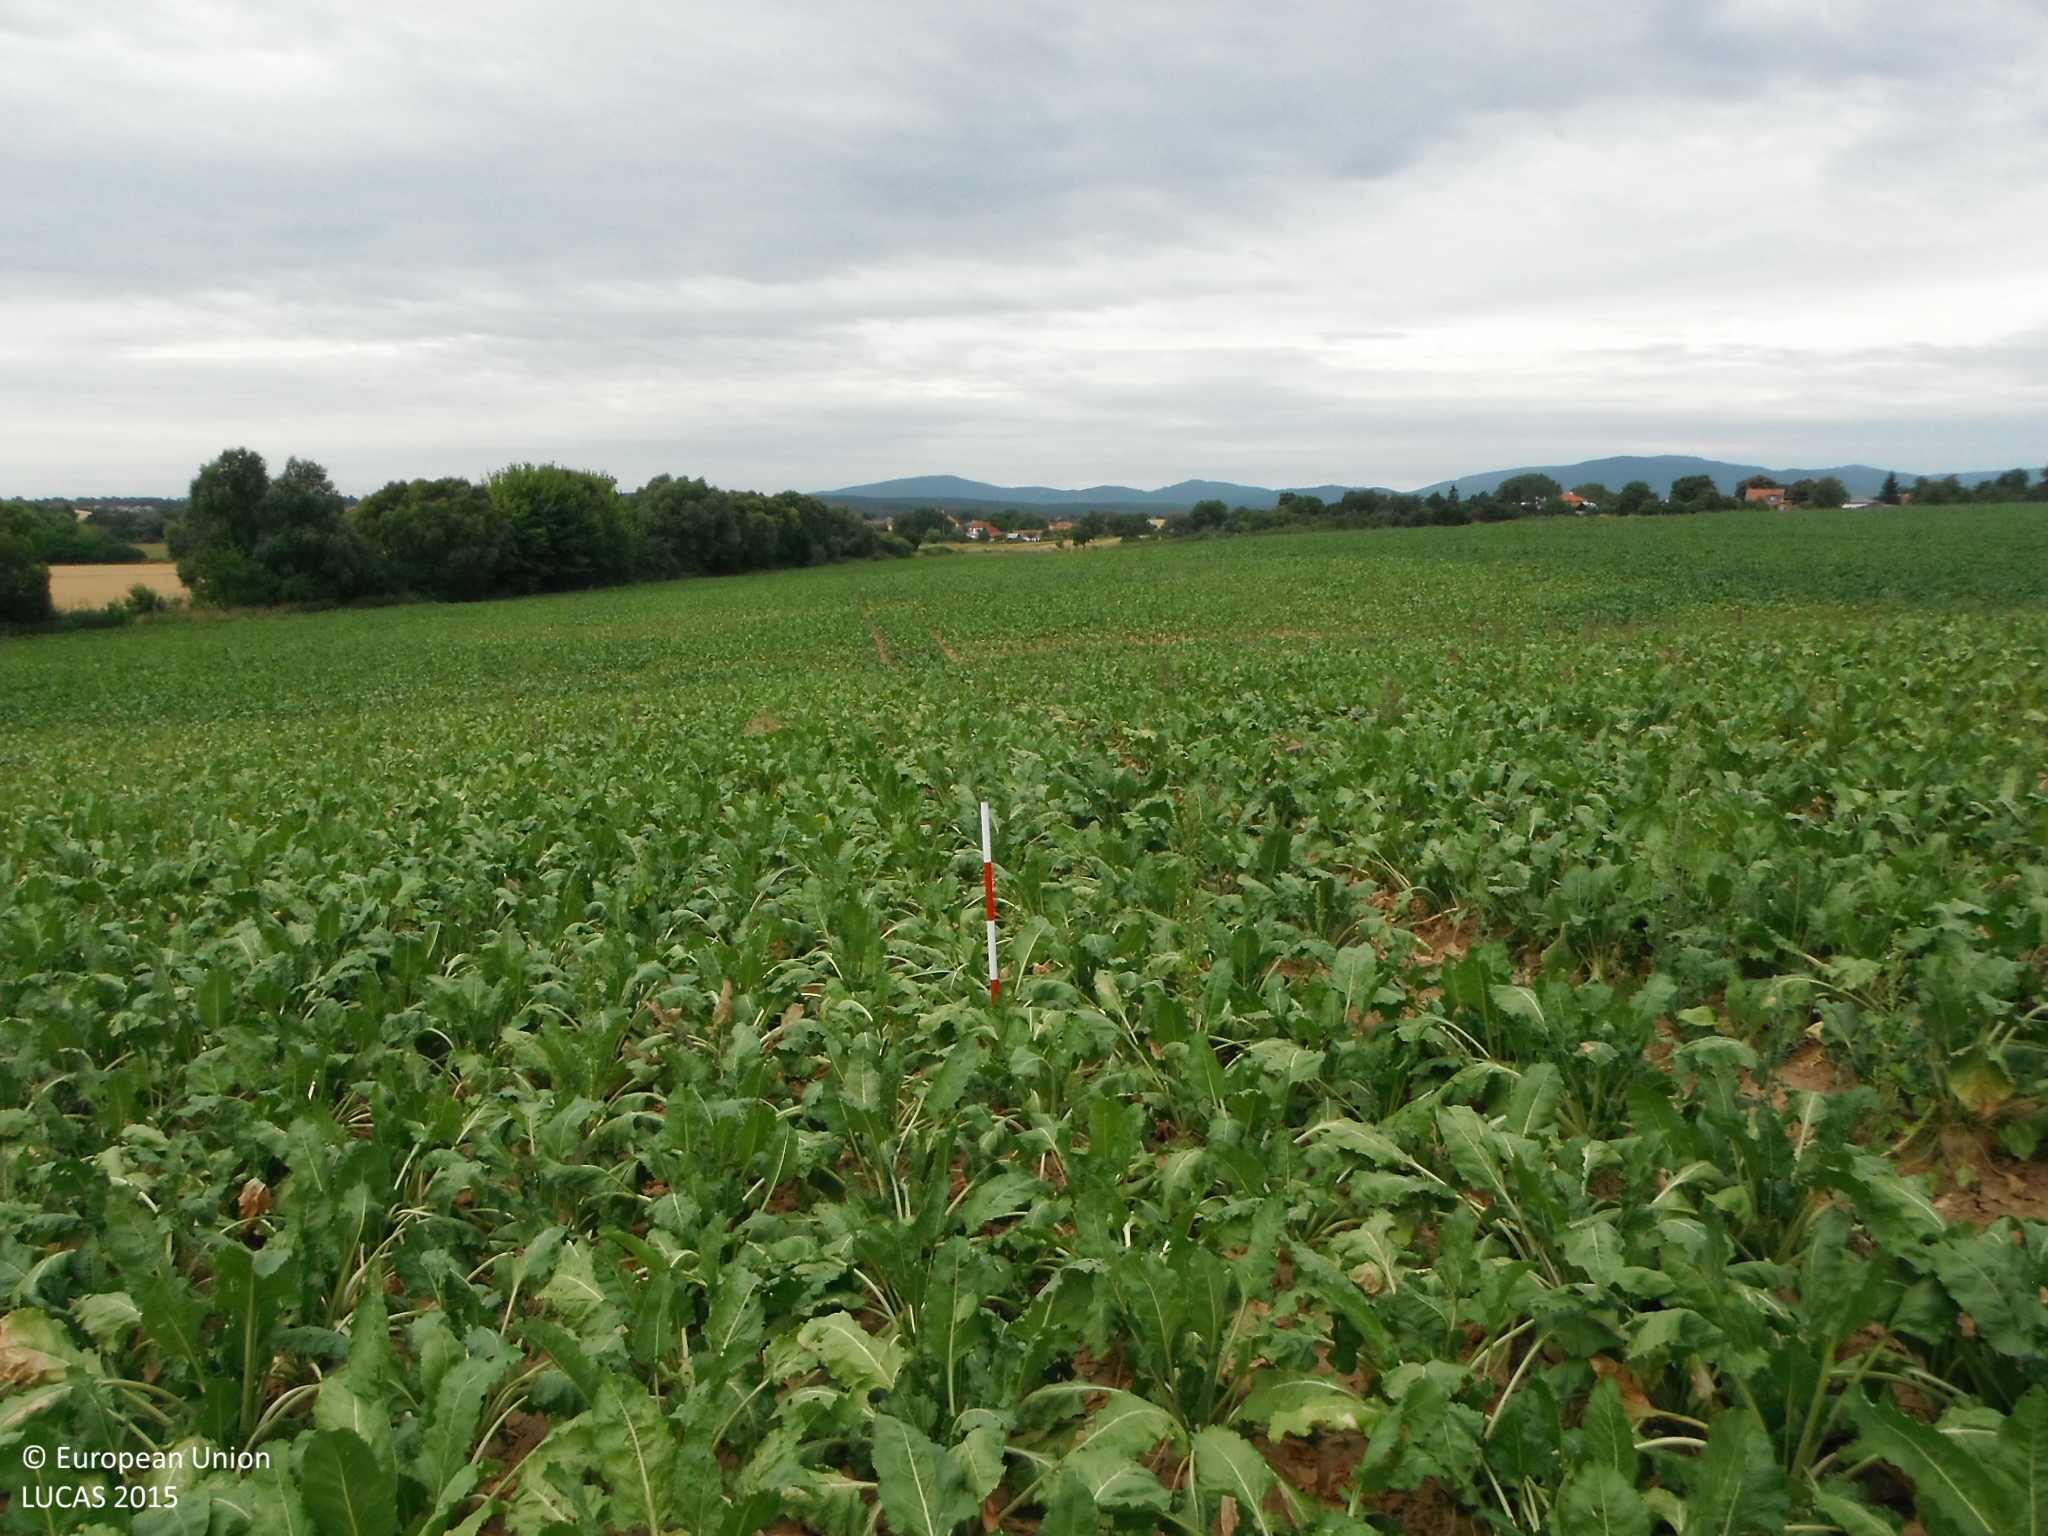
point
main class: Cropland
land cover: Sugar beet
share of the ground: > 75 %
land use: Agriculture (excluding fallow land and kitchen gardens)
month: July
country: SK
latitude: 48.6570
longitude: 18.2286
